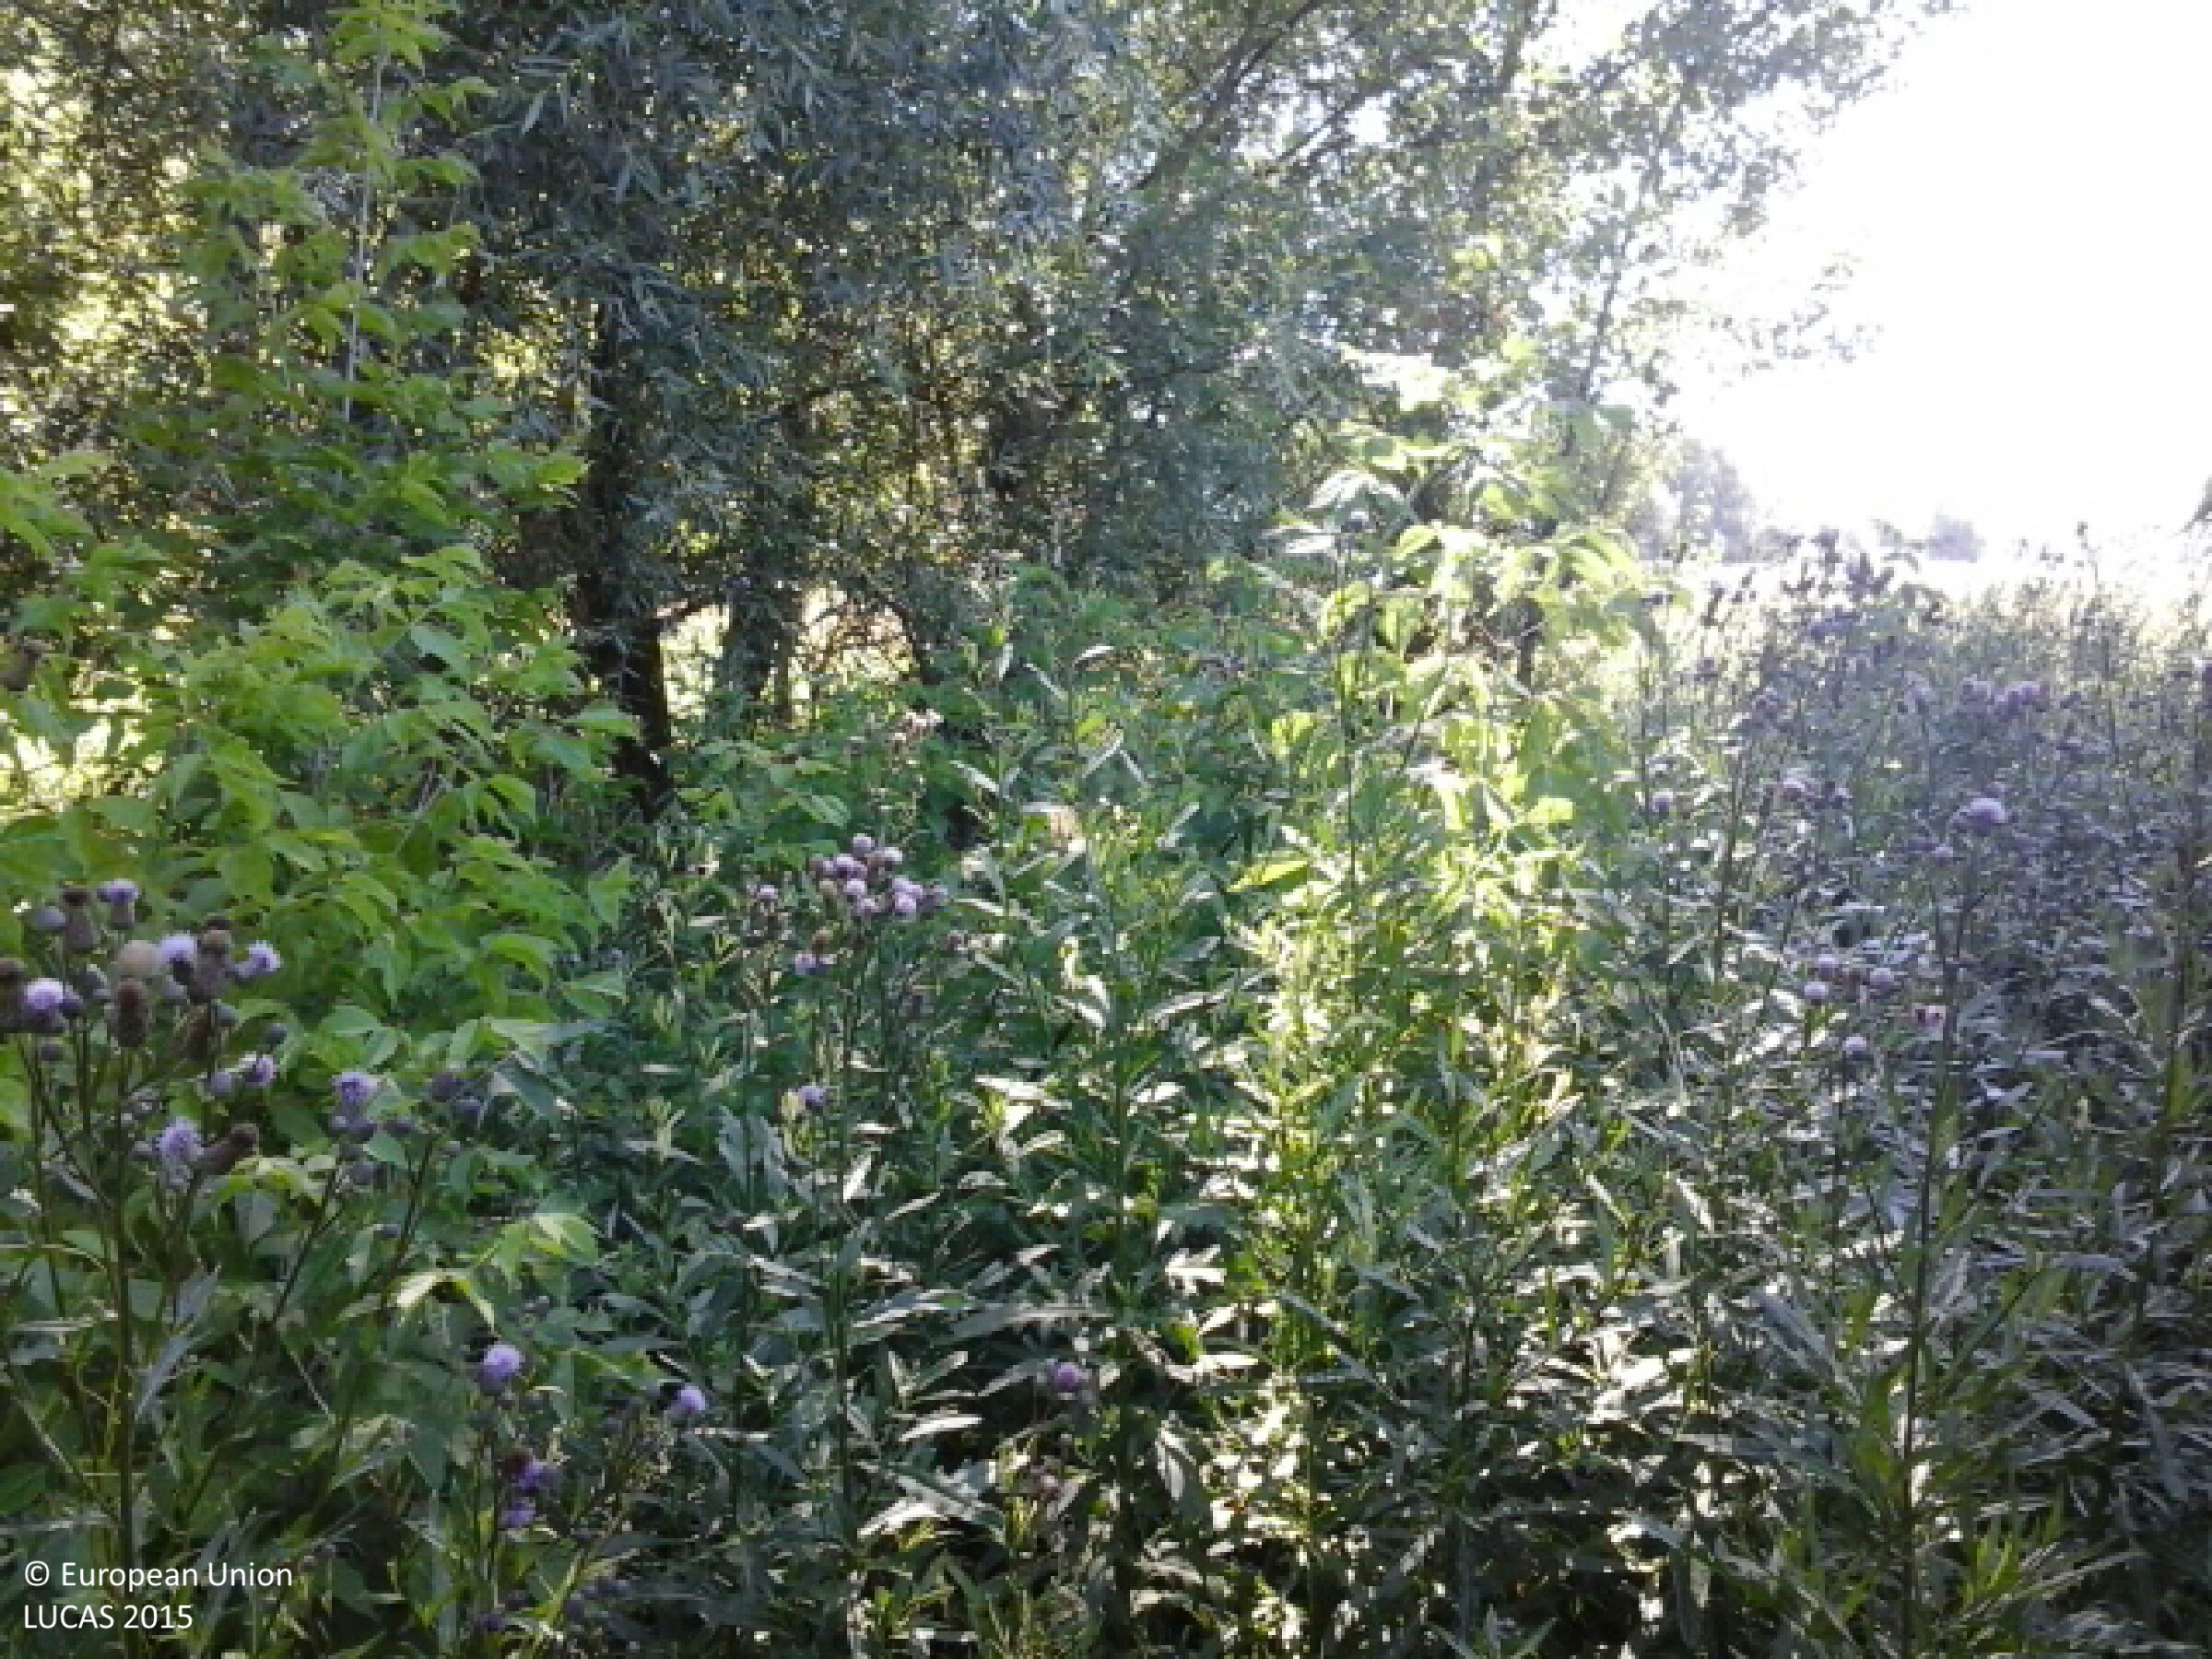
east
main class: Woodland
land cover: Broadleaved woodland
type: mesophytic deciduous forest
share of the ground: > 75 %
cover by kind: broadleaved forest trees 90 %, herbaceous plants 10 %
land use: Semi-natural and natural areas not in use
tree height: > 5 m
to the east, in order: Broadleaved woodland; Grassland without tree/shrub cover
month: July
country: HU
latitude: 48.3201
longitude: 21.5780
